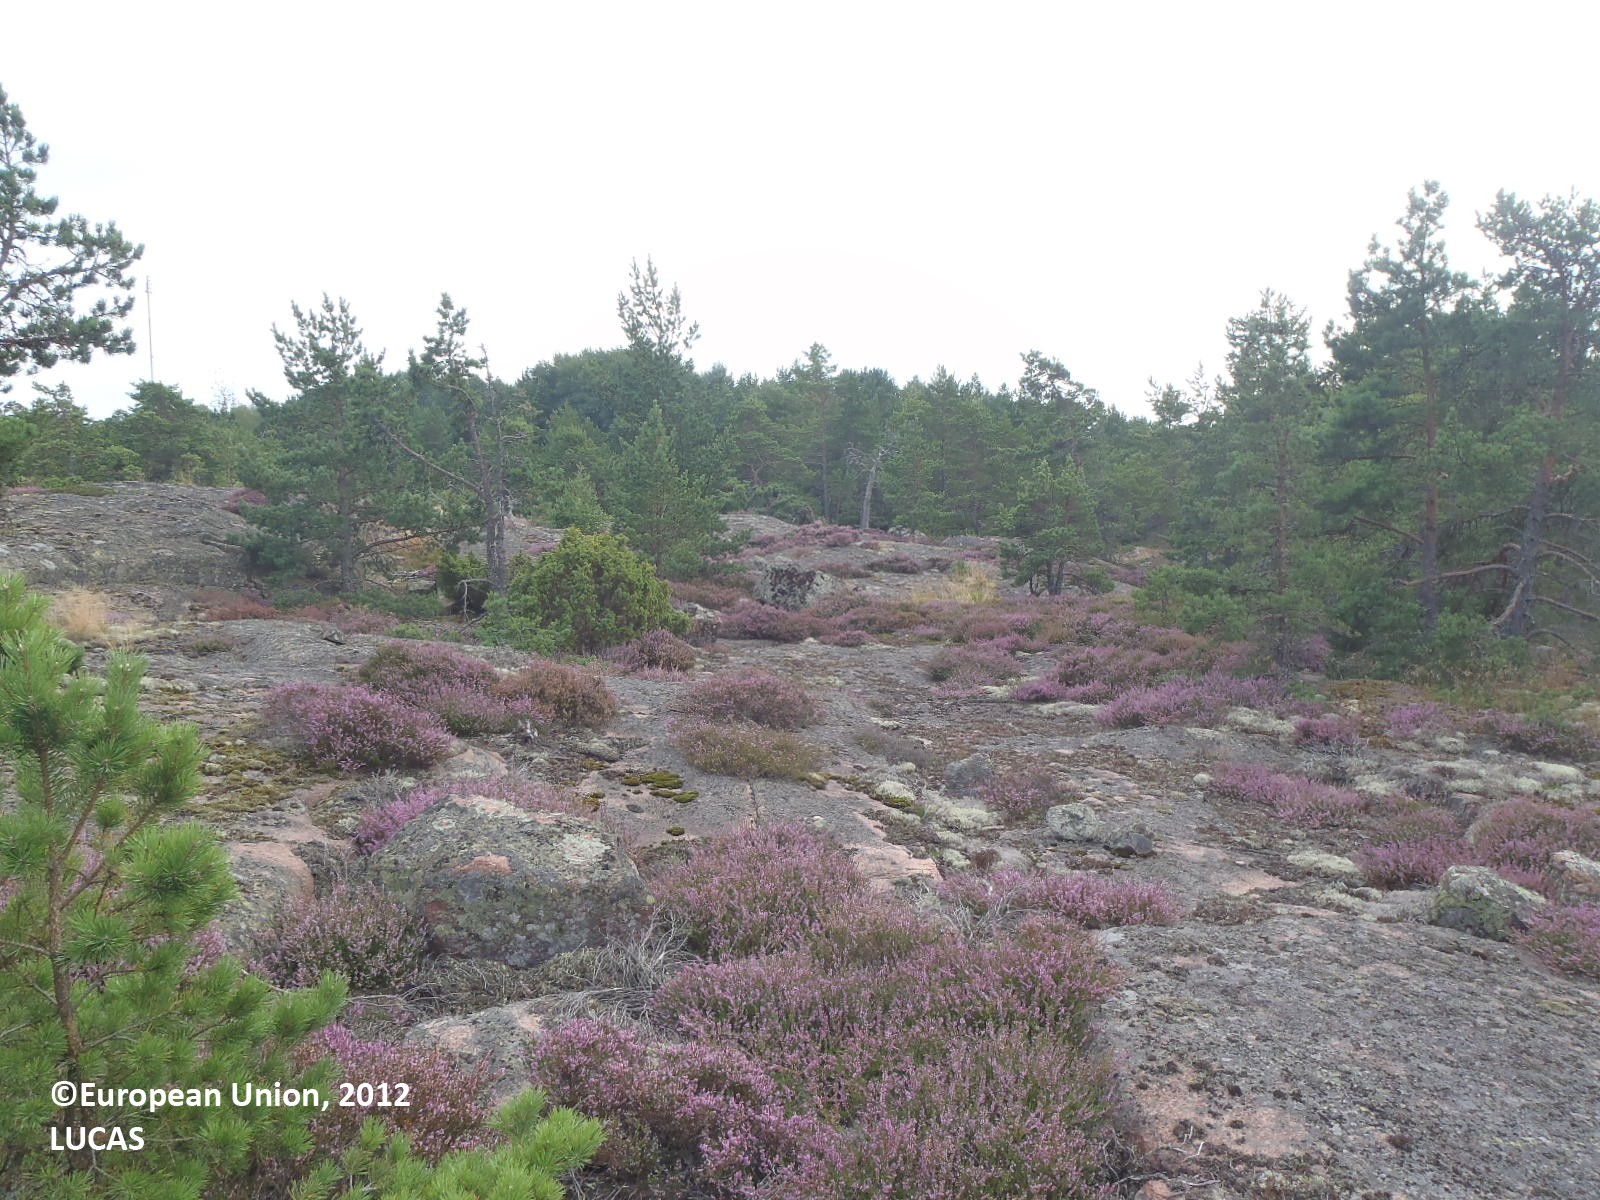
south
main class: Woodland
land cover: Pine dominated coniferous woodland
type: boreal forest
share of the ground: 10 - 25 %
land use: Semi-natural and natural areas not in use
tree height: > 5 m
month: August
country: FI
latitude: 60.2321
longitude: 20.3928
